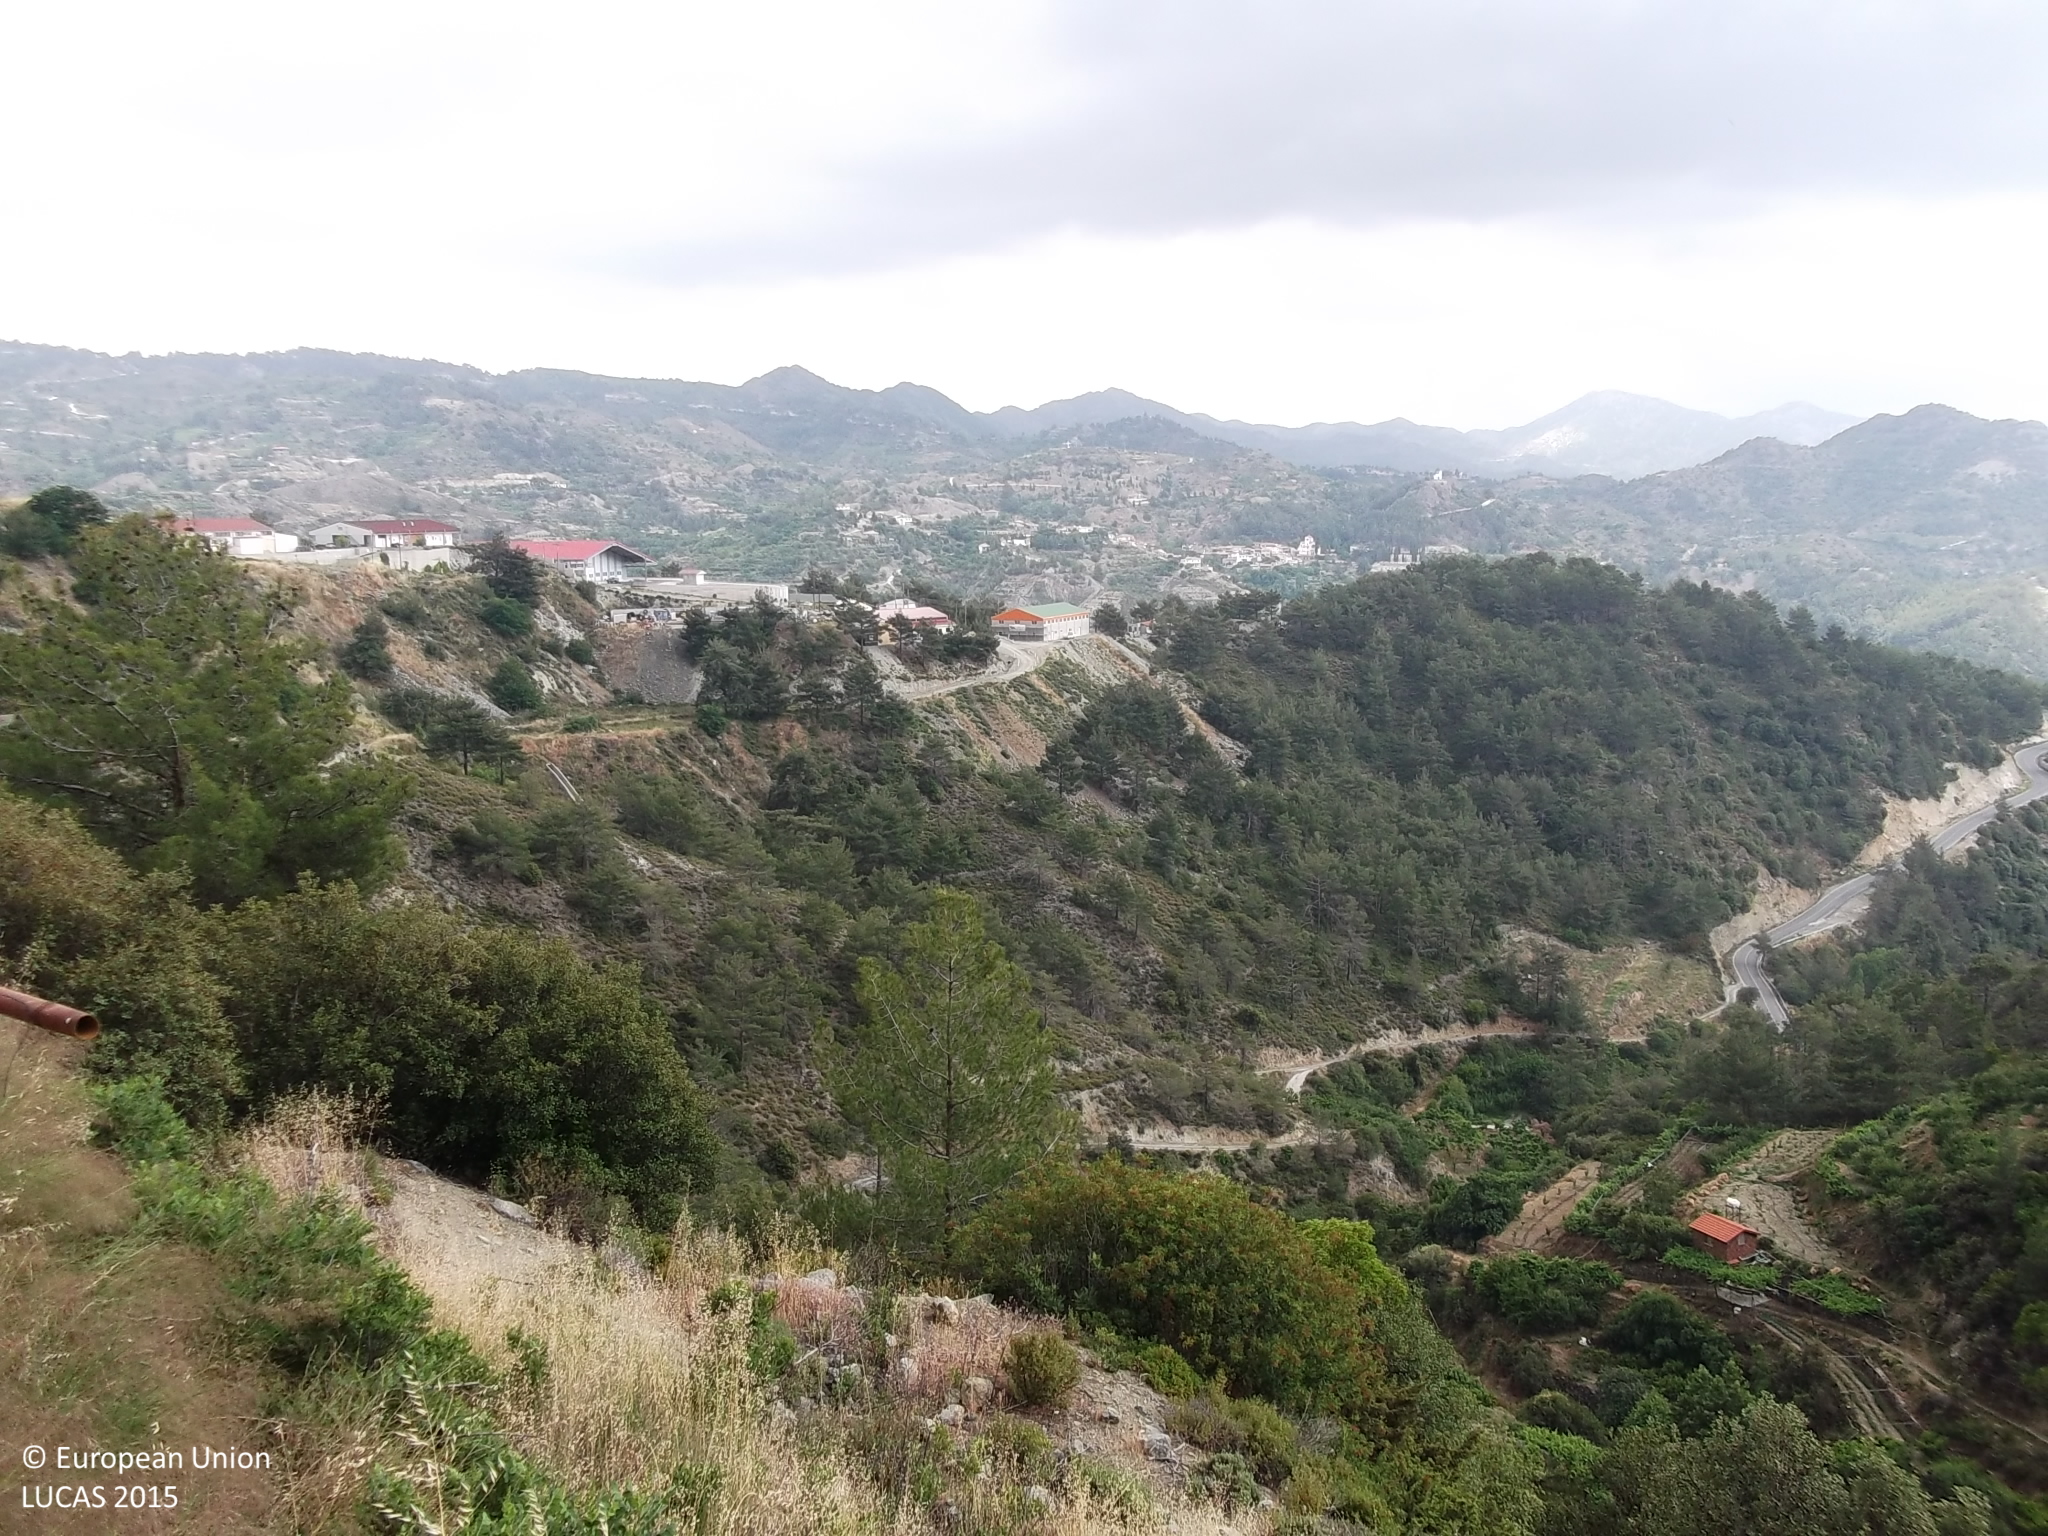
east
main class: Woodland
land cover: Broadleaved woodland
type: broadleaved evergreen forest
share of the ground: 10 - 25 %
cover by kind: shrubs 35 %, broadleaved forest trees 20 %, unconsolidated bare surface 20 %, herbaceous plants 15 %, coniferous forest trees 5 %, consolidated bare surface 5 %
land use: Semi-natural and natural areas not in use
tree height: > 5 m
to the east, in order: Broadleaved woodland; Shrubland with sparse tree cover; Nuts trees; Tracks; Shrubland with sparse tree cover; Nuts trees; Tracks; Other fruit trees and berries; Nuts trees; Apple fruit; Cherry fruit; Tracks; Pine dominated coniferous woodland
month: June
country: CY
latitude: 34.9317
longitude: 32.9746
